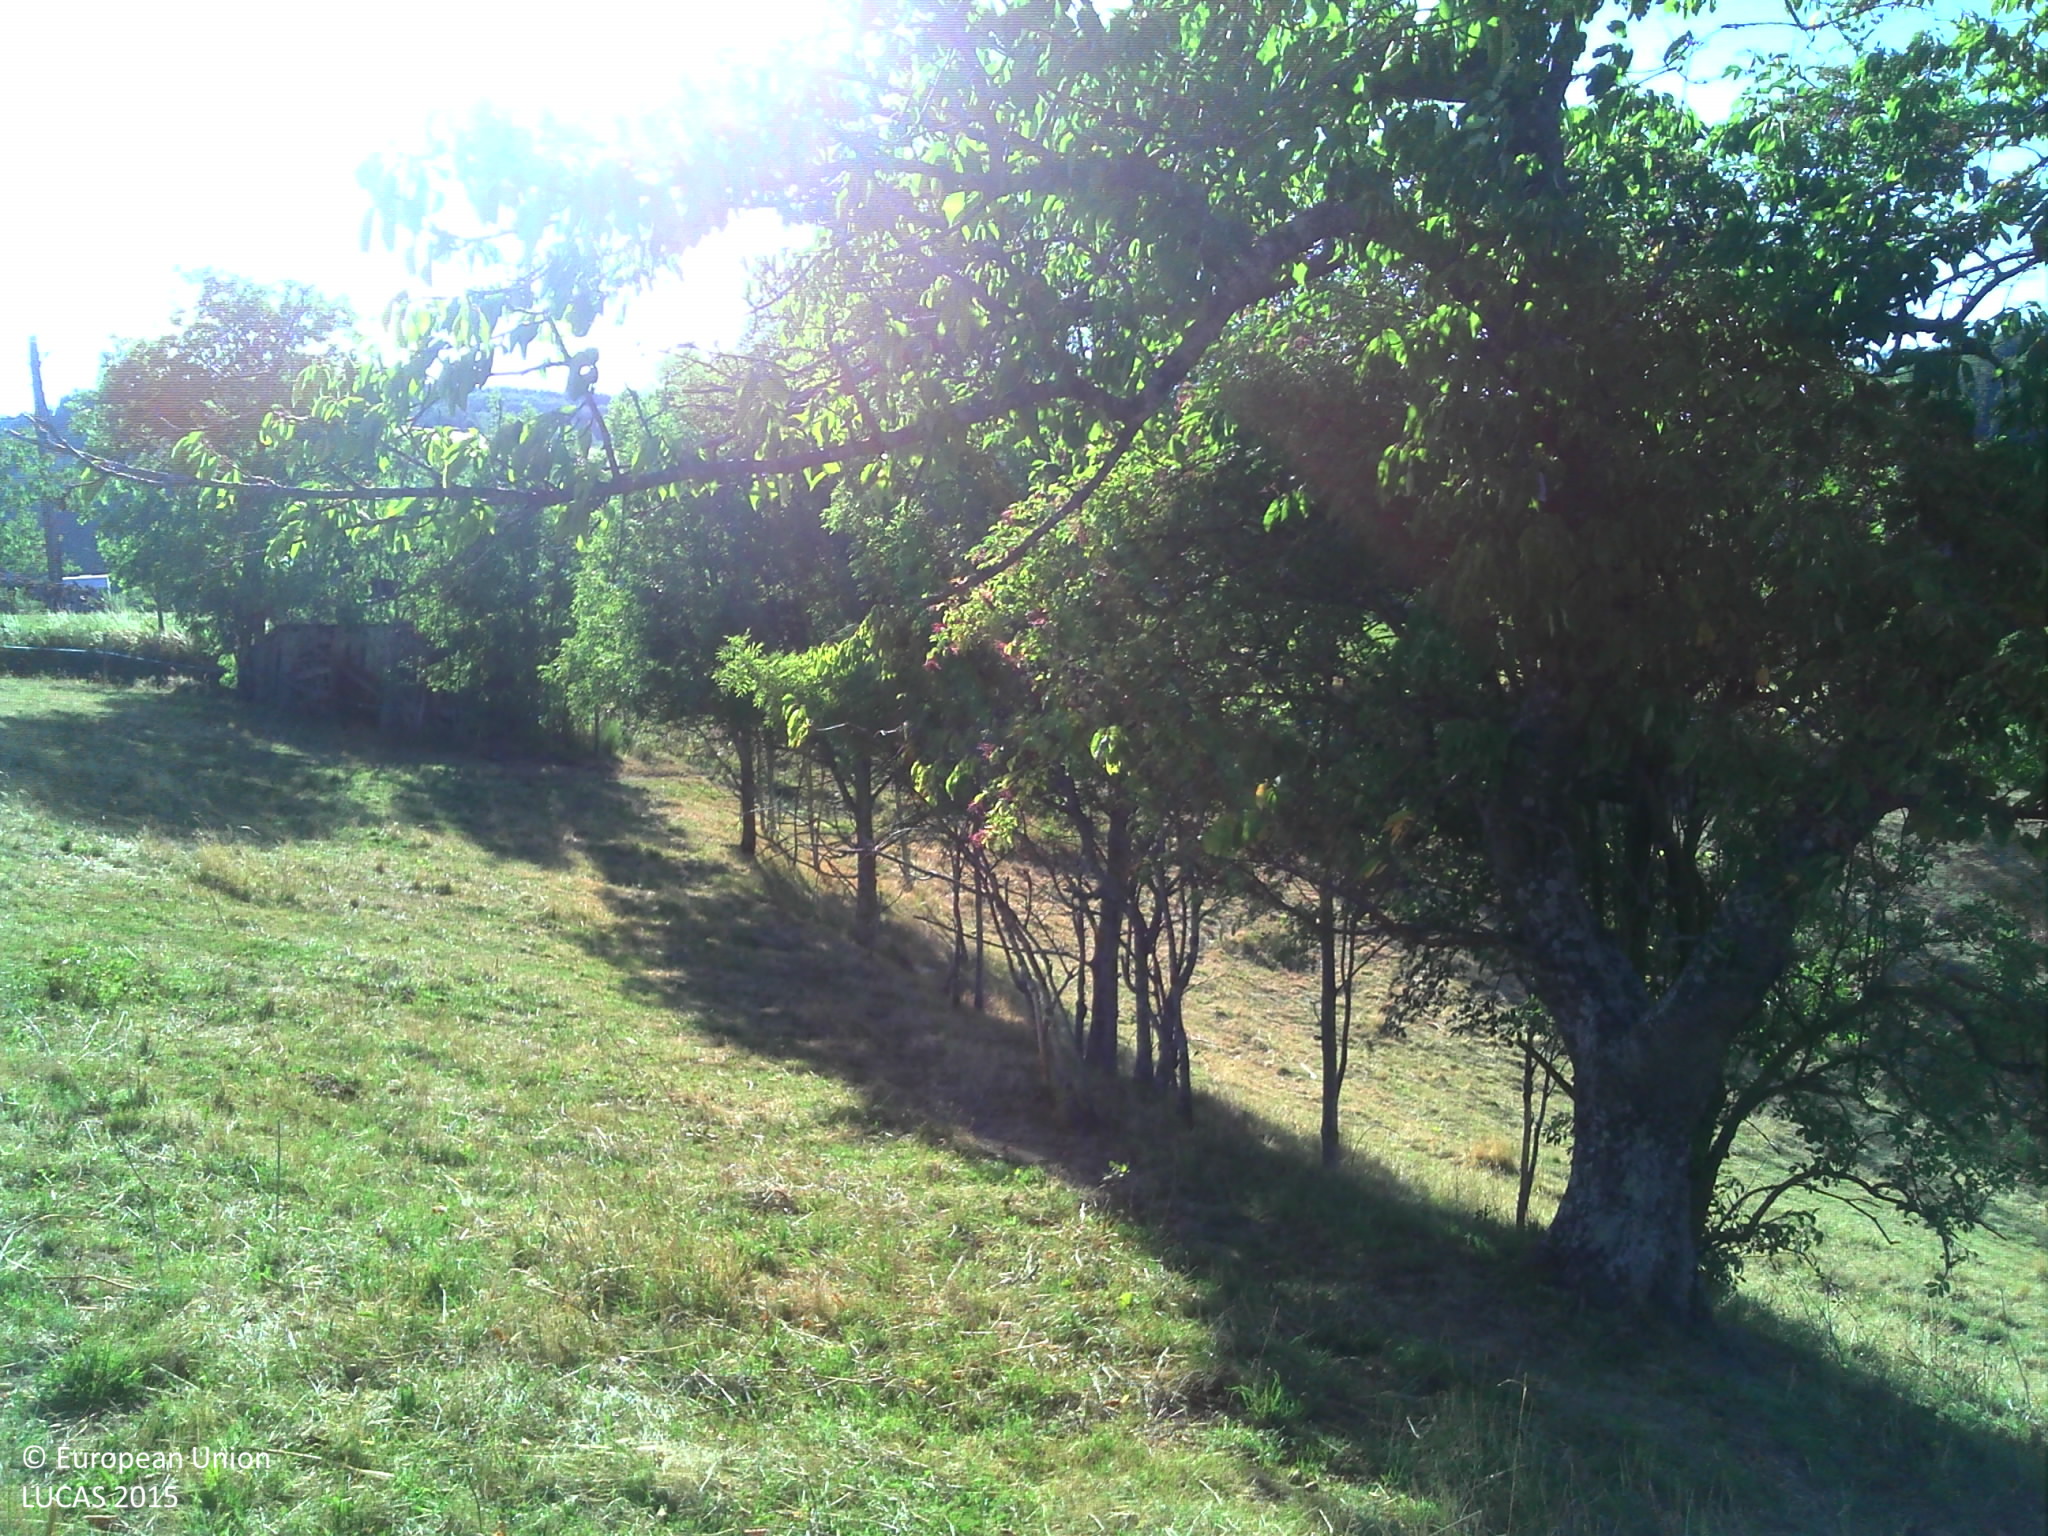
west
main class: Grassland
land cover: Grassland without tree/shrub cover
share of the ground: > 75 %
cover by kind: herbaceous plants 100 %
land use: Agriculture (excluding fallow land and kitchen gardens)
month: July
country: FR
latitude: 44.9504
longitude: 4.5932
